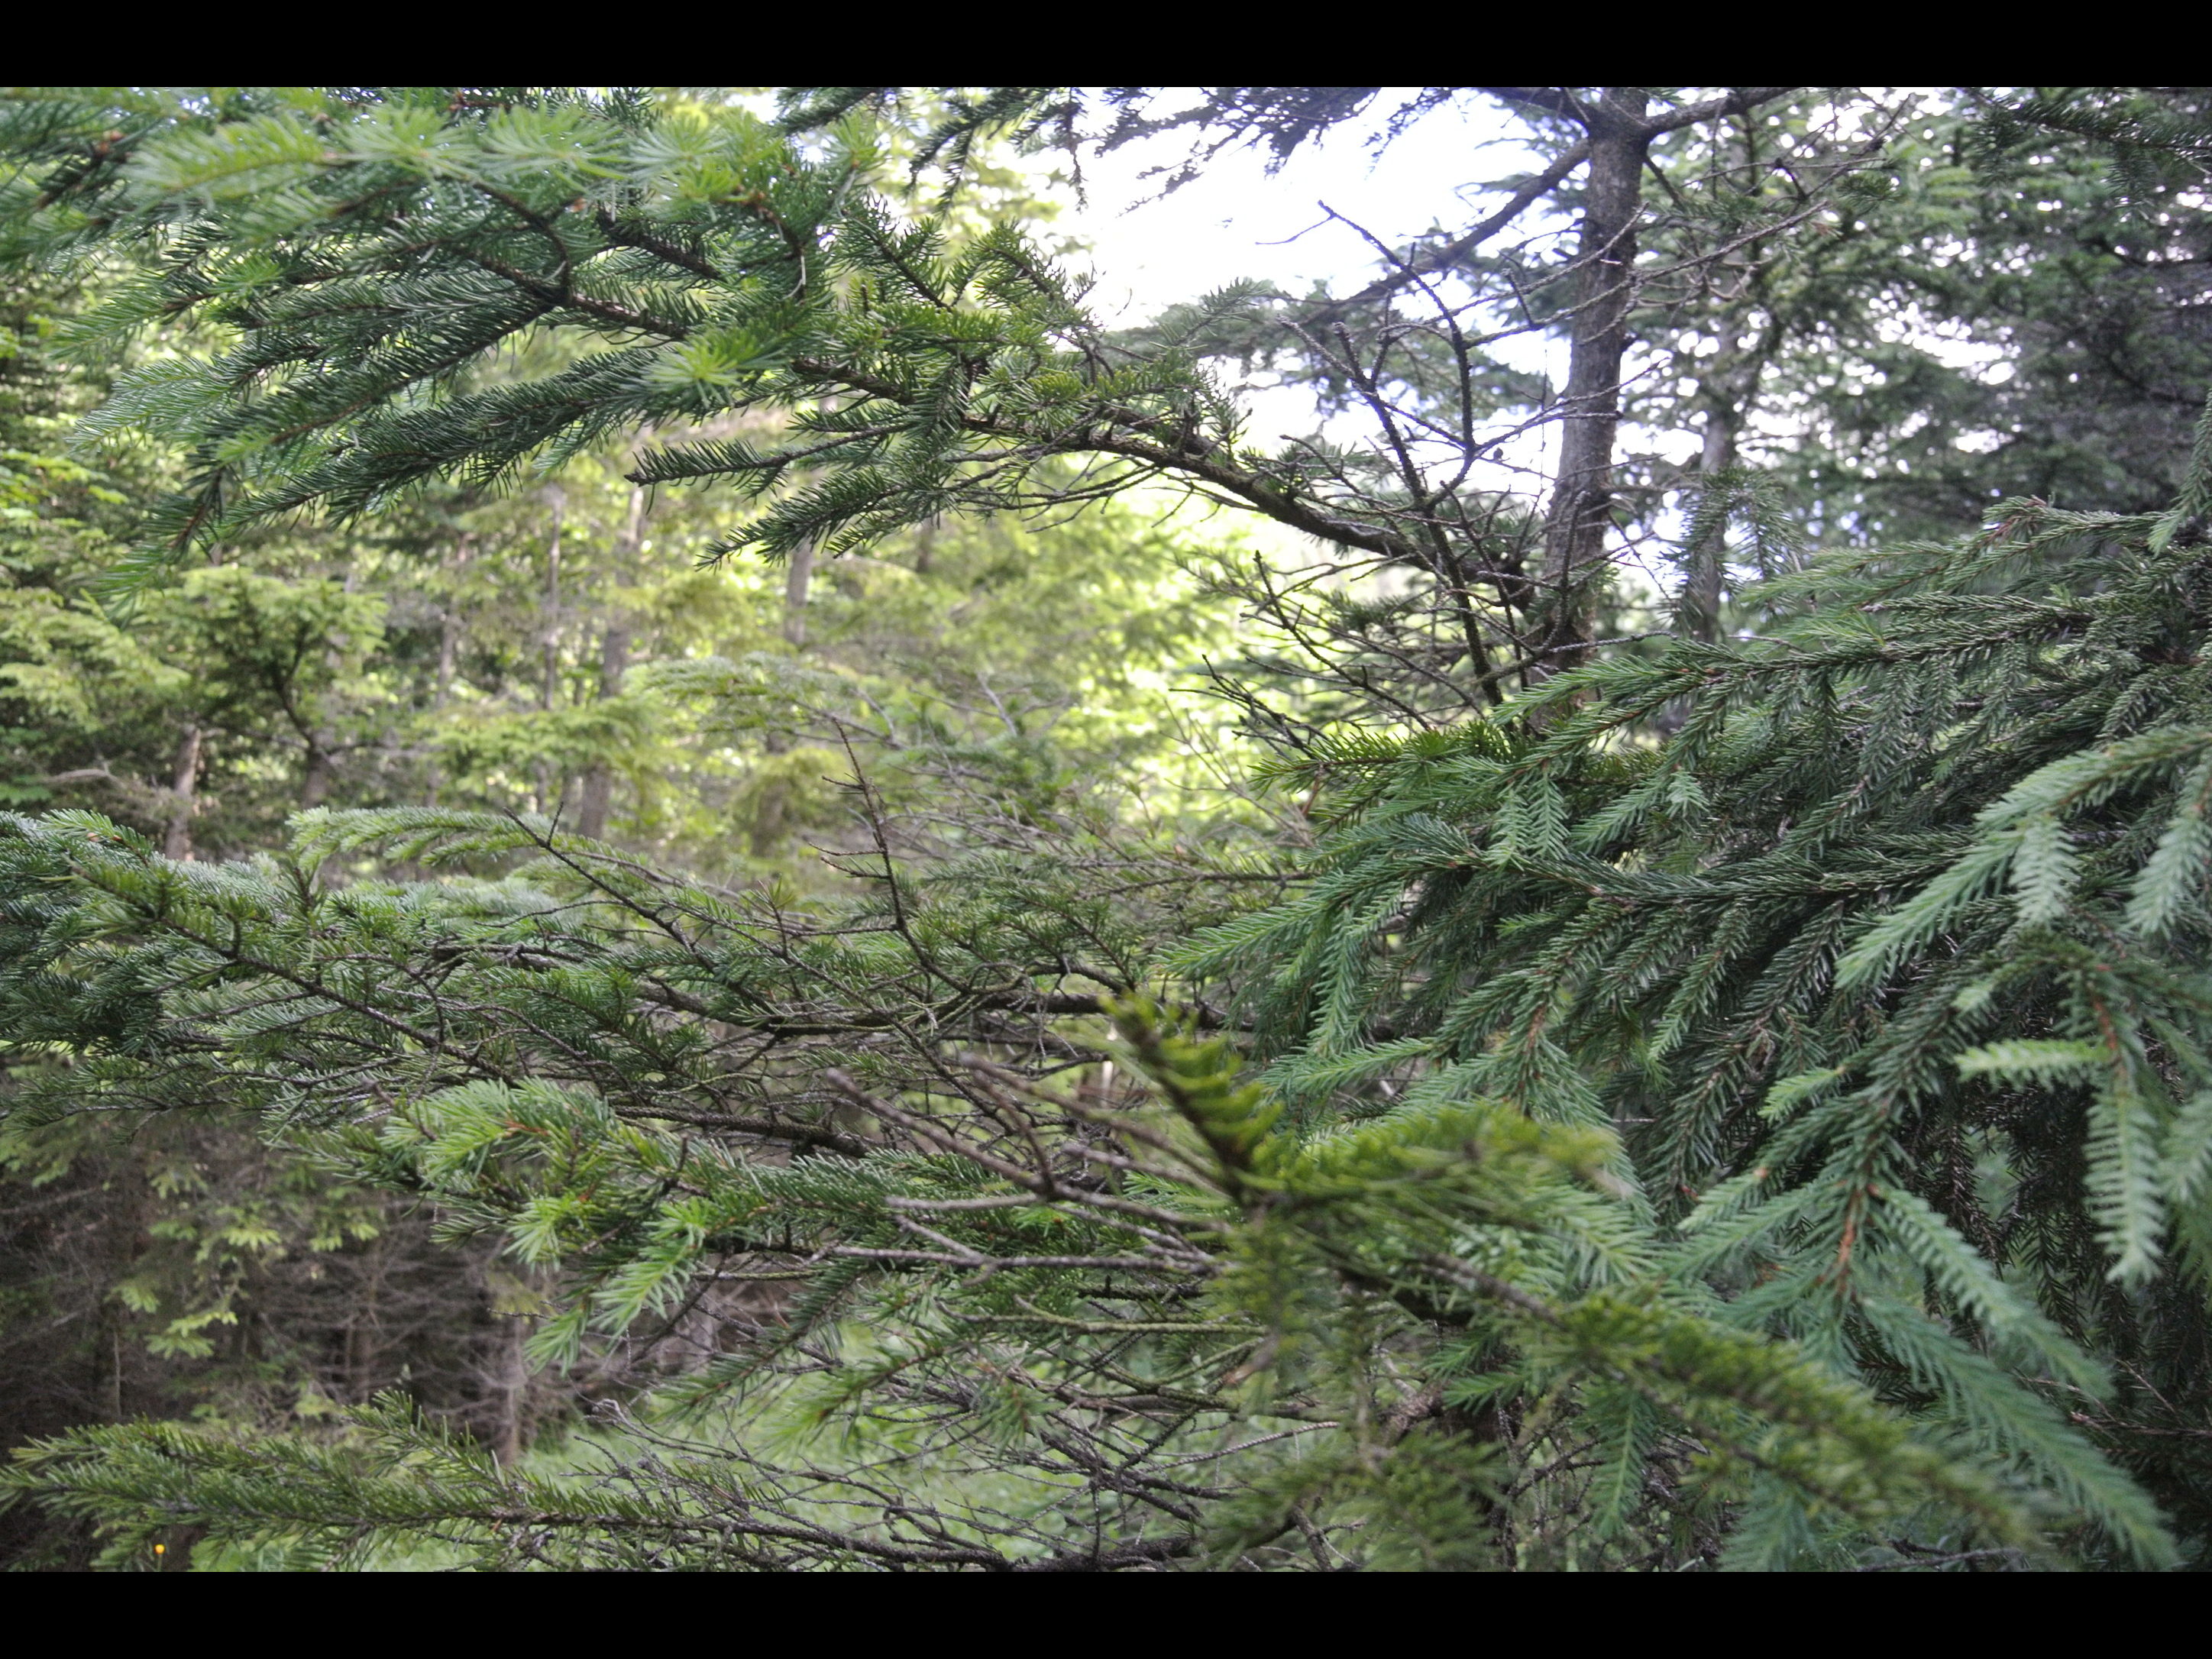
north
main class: Woodland
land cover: Spruce dominated coniferous woodland
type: alpine coniferous forest
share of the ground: > 75 %
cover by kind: coniferous forest trees 90 %, herbaceous plants 10 %
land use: Forestry
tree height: > 5 m
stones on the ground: > 50 %
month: June
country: AT
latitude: 47.8574
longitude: 15.3879
